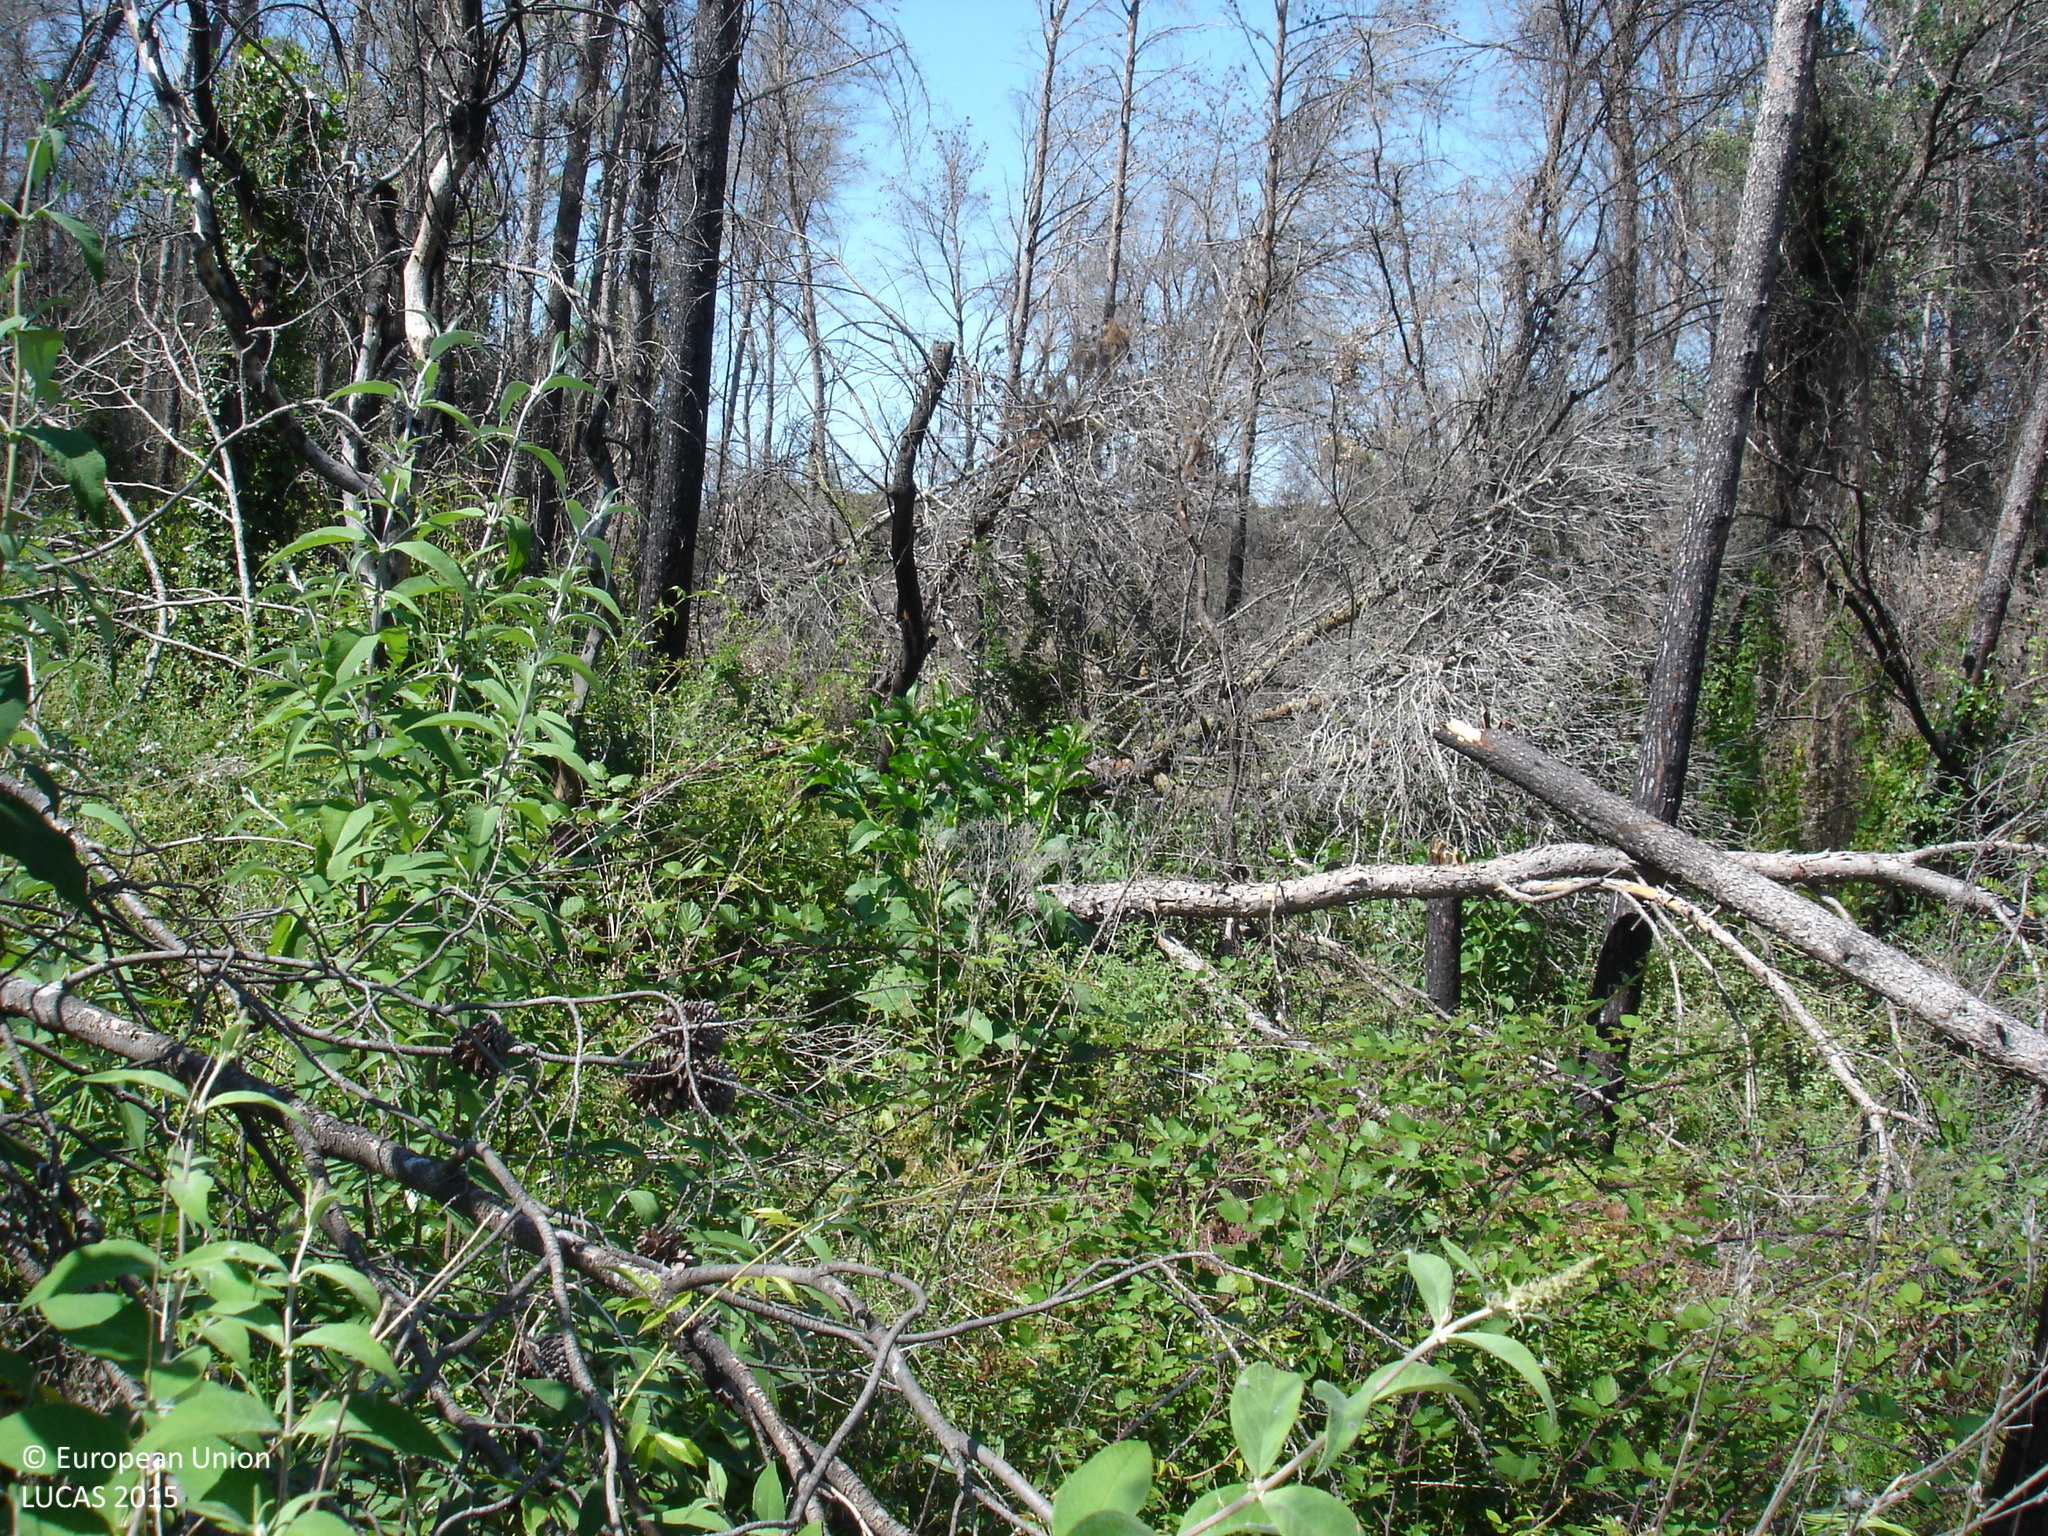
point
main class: Woodland
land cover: Pine dominated coniferous woodland
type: coniferous forest of the mediterranean region
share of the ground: 25 - 50 %
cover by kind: shrubs 55 %, coniferous forest trees 45 %
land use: Forestry
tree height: > 5 m
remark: Burnt area
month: May
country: ES
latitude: 42.0669
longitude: 2.9937
